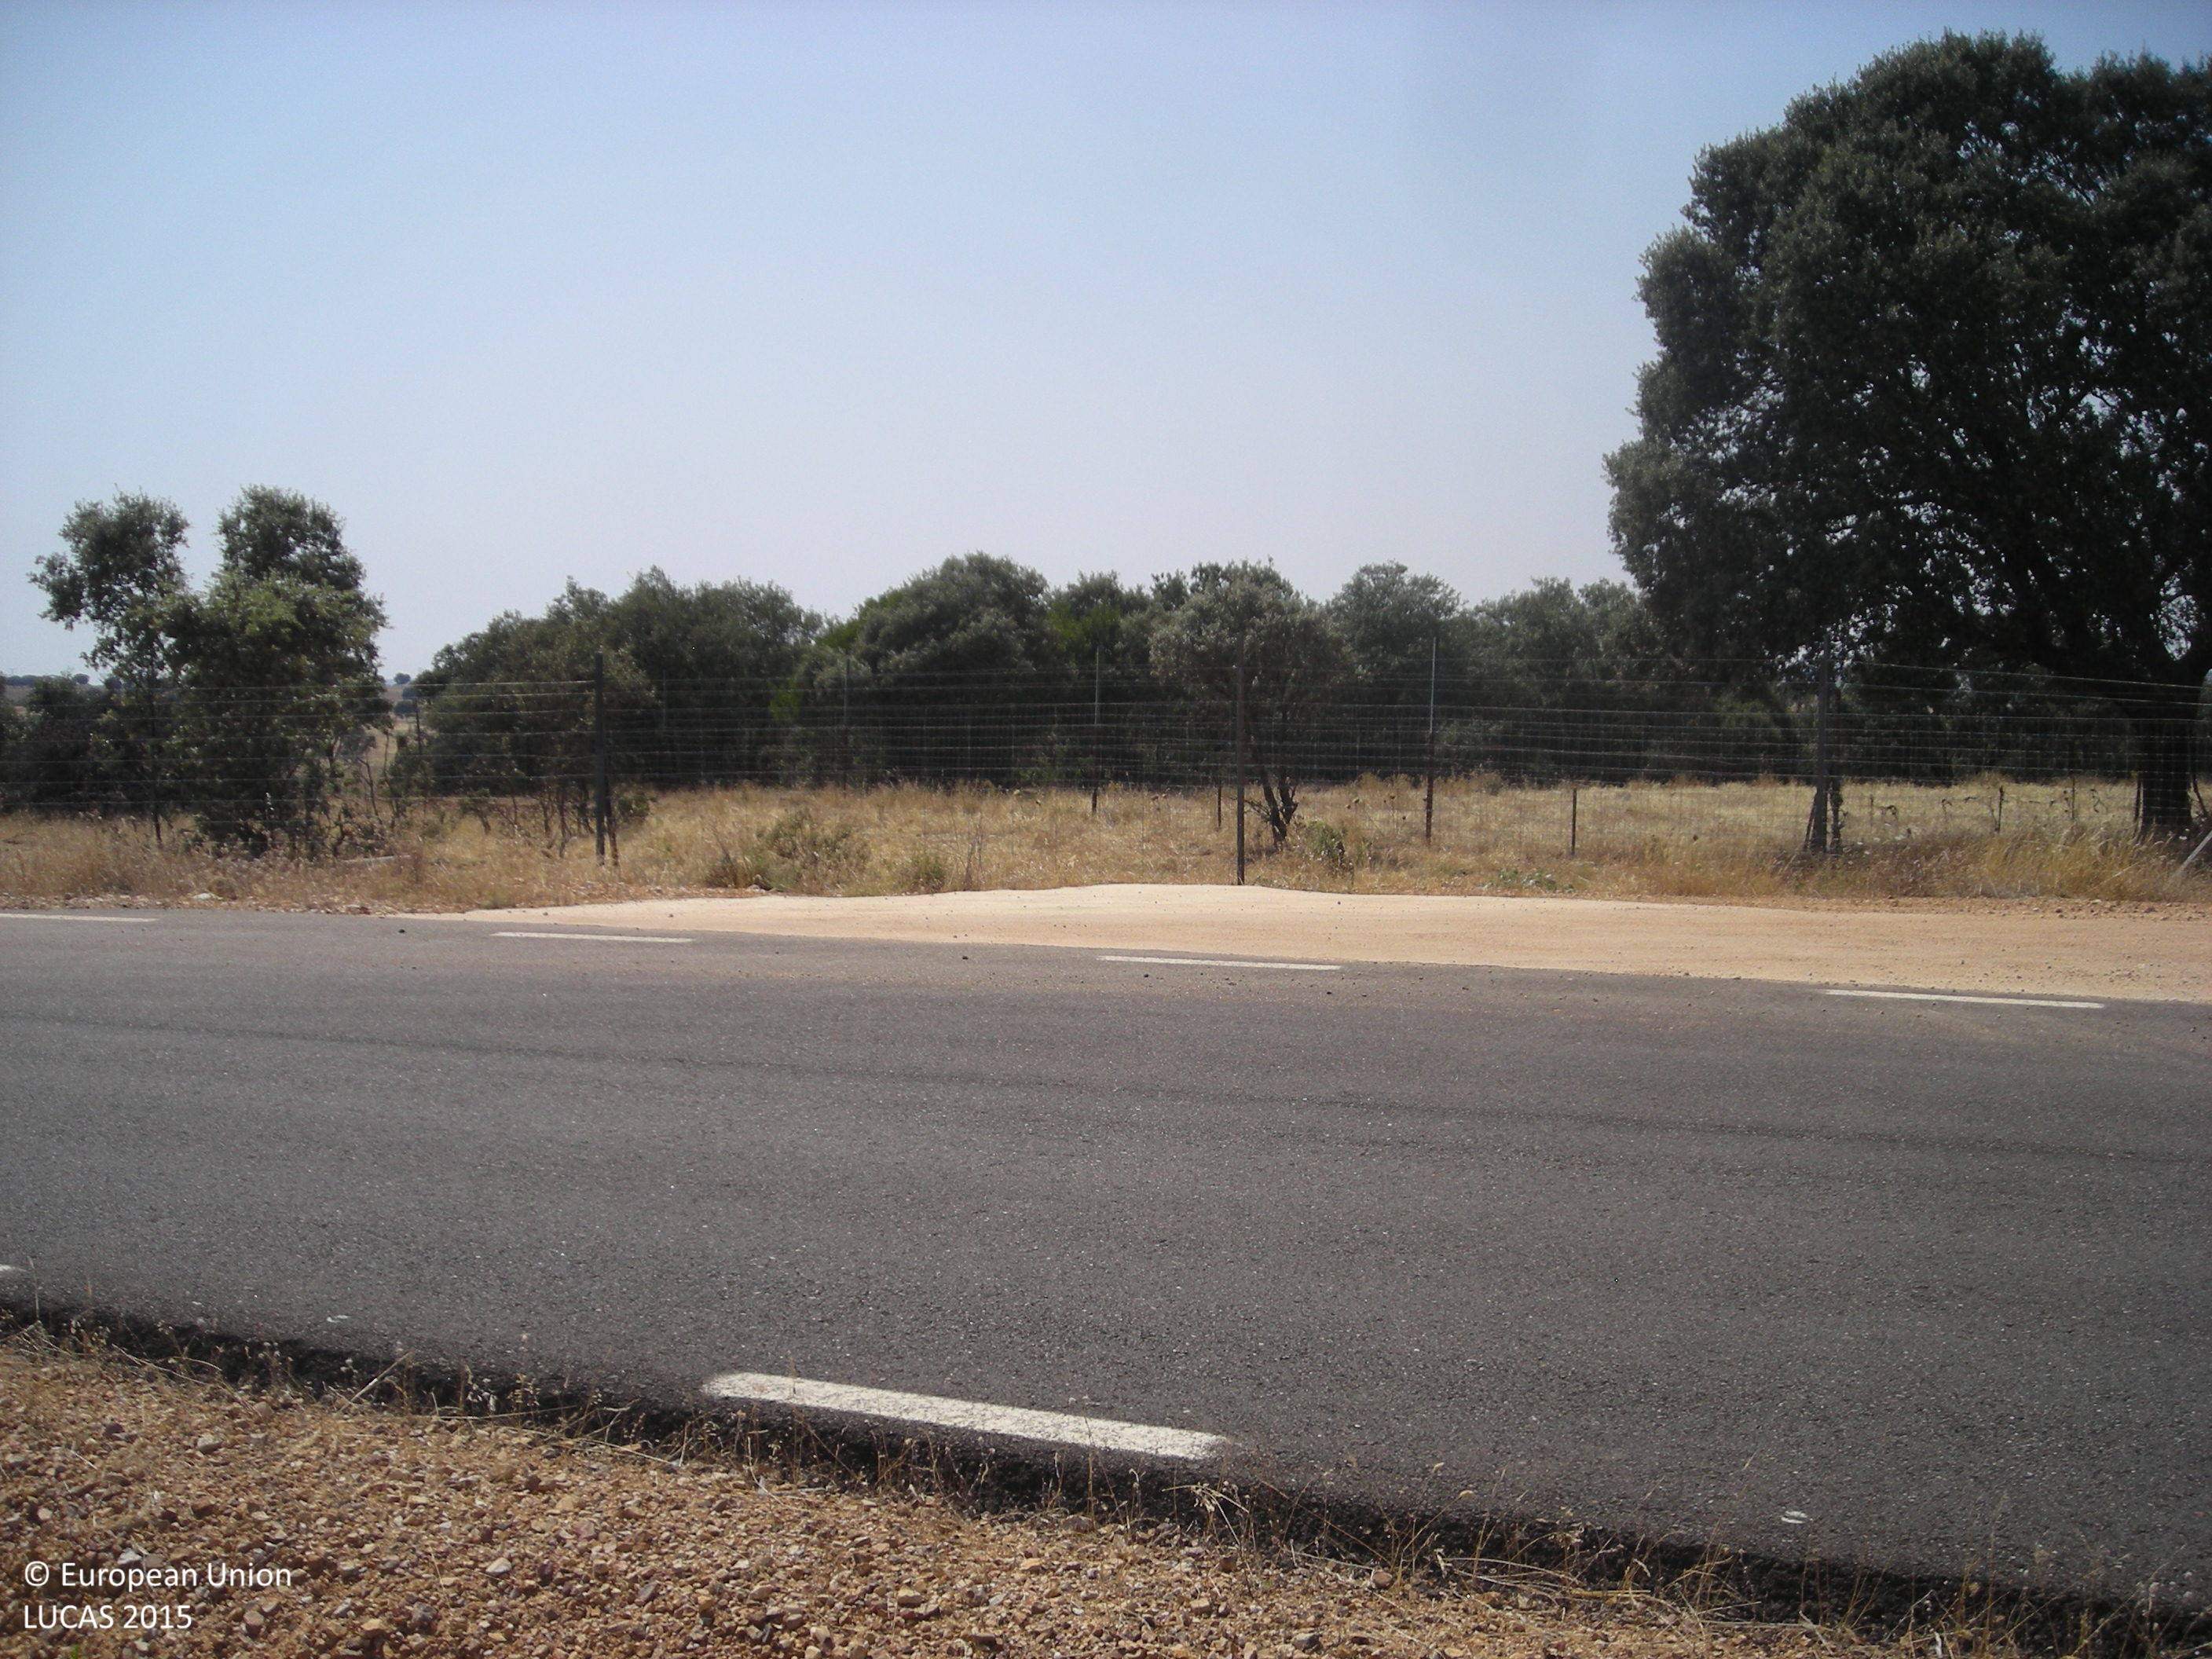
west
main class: Cropland
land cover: Olive groves
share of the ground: 25 - 50 %
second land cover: Grassland without tree/shrub cover
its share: 25 - 50 %
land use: Agriculture (excluding fallow land and kitchen gardens)
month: July
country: ES
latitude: 39.2212
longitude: -5.3221
